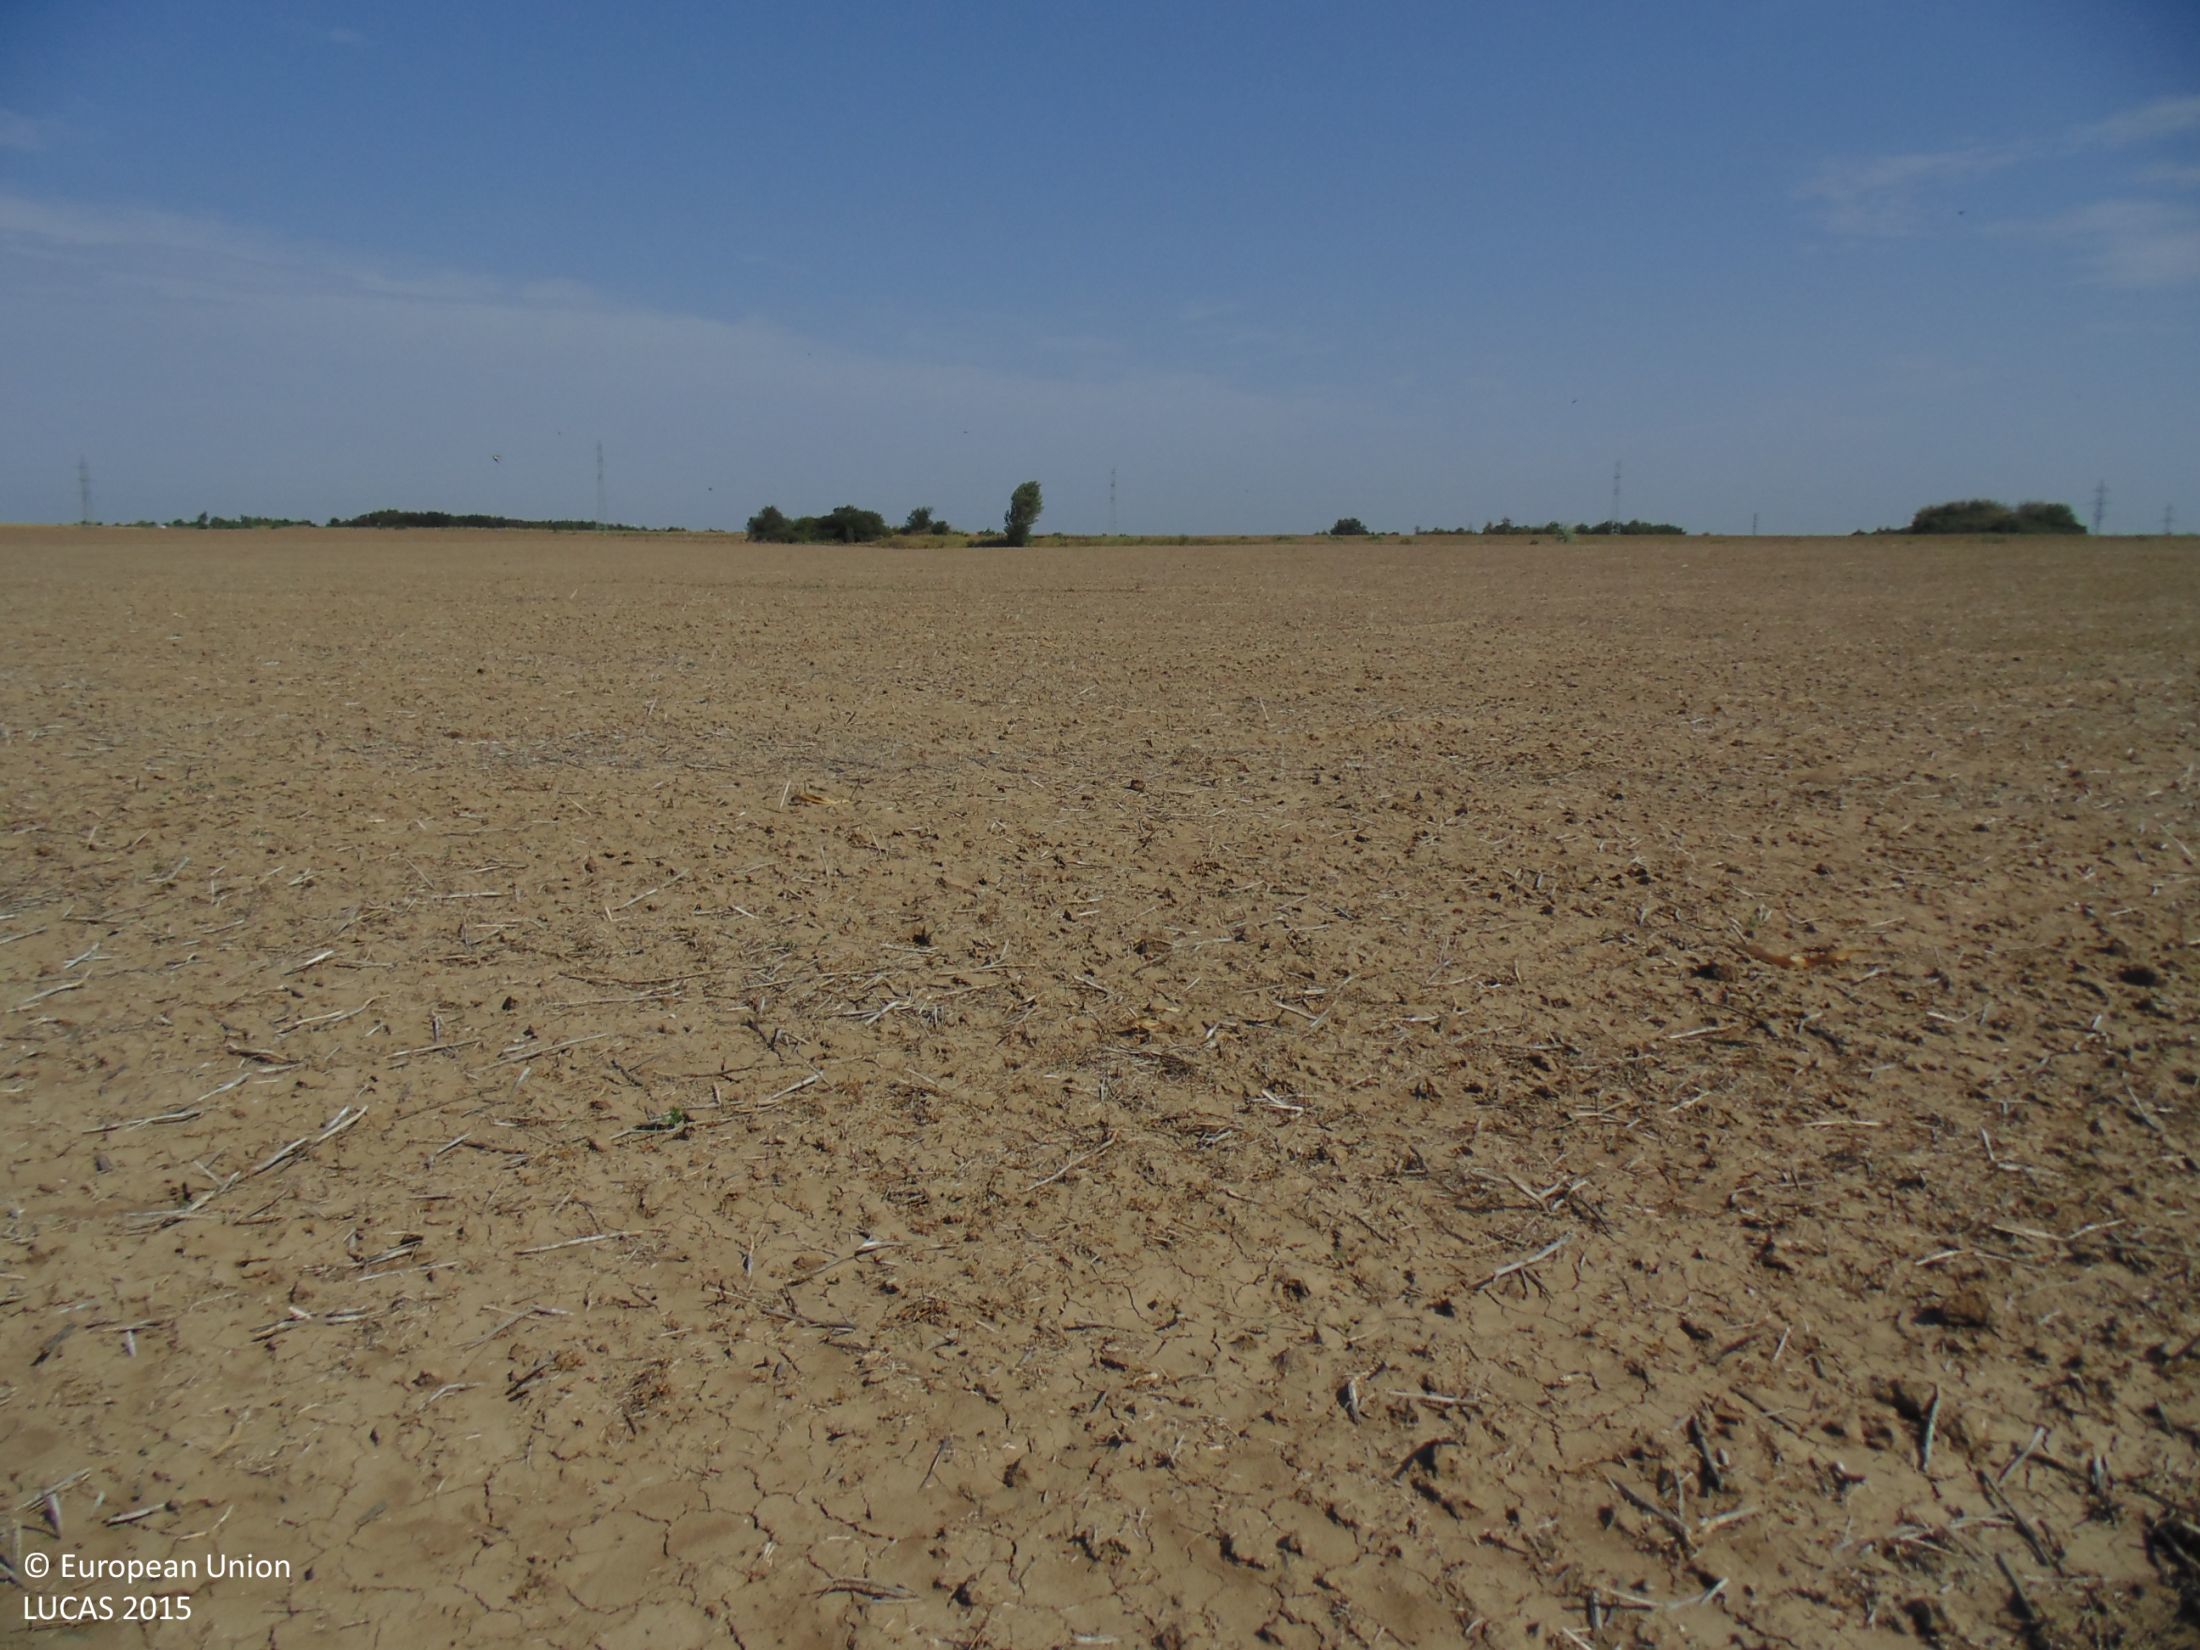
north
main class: Cropland
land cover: Rape and turnip rape
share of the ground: < 10 %
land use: Agriculture (excluding fallow land and kitchen gardens)
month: September
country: BG
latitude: 44.0793
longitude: 27.2001
